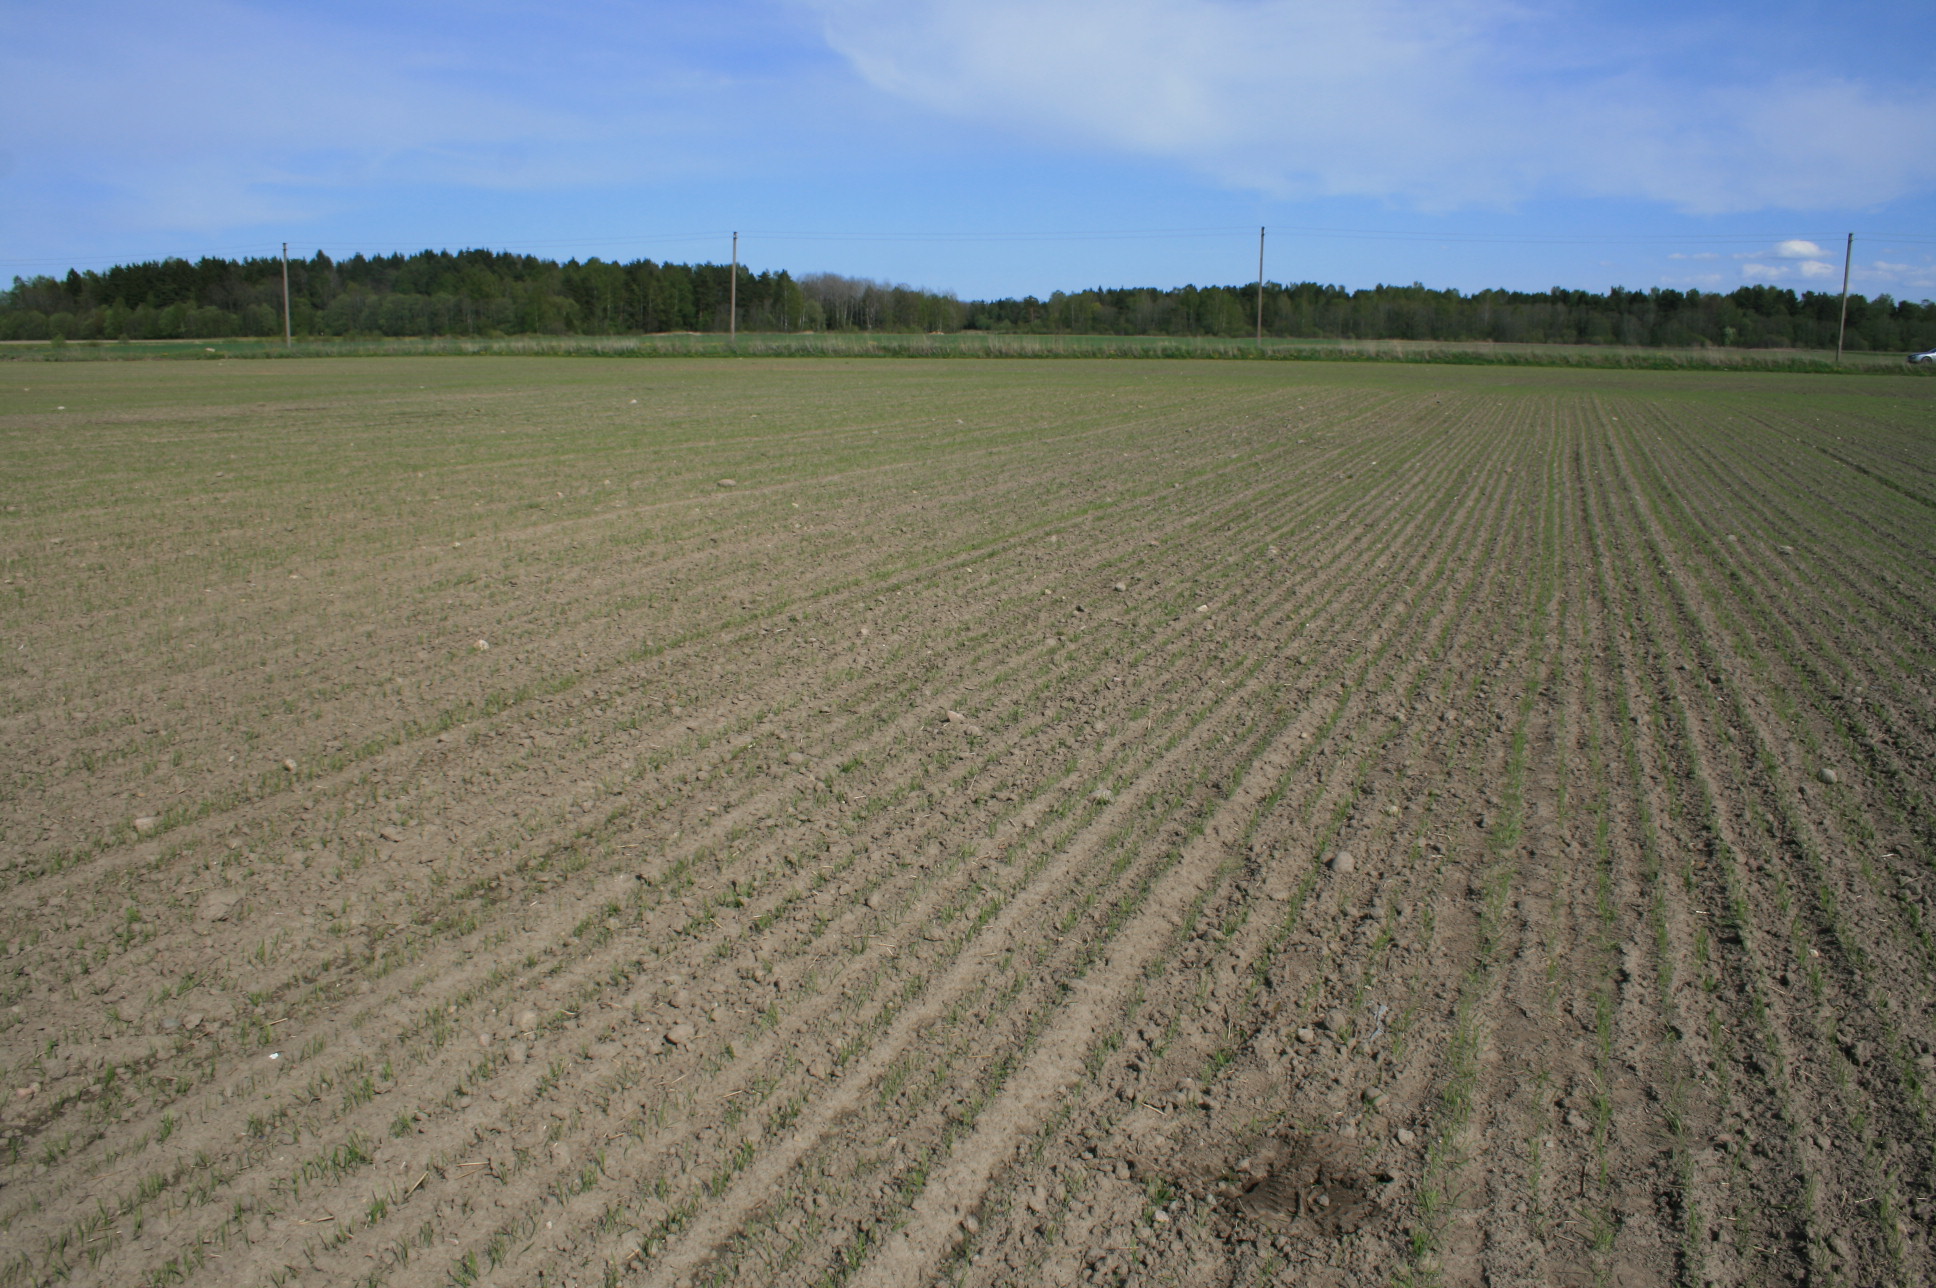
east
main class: Cropland
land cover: Barley
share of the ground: 10 - 25 %
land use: Agriculture (excluding fallow land and kitchen gardens)
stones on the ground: < 10 %
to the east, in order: Barley; Grass margins; Paved roads, cycling and walking lanes; Grass margins; Electric lines; Common wheat
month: May
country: LT
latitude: 55.9742
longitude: 21.3390
